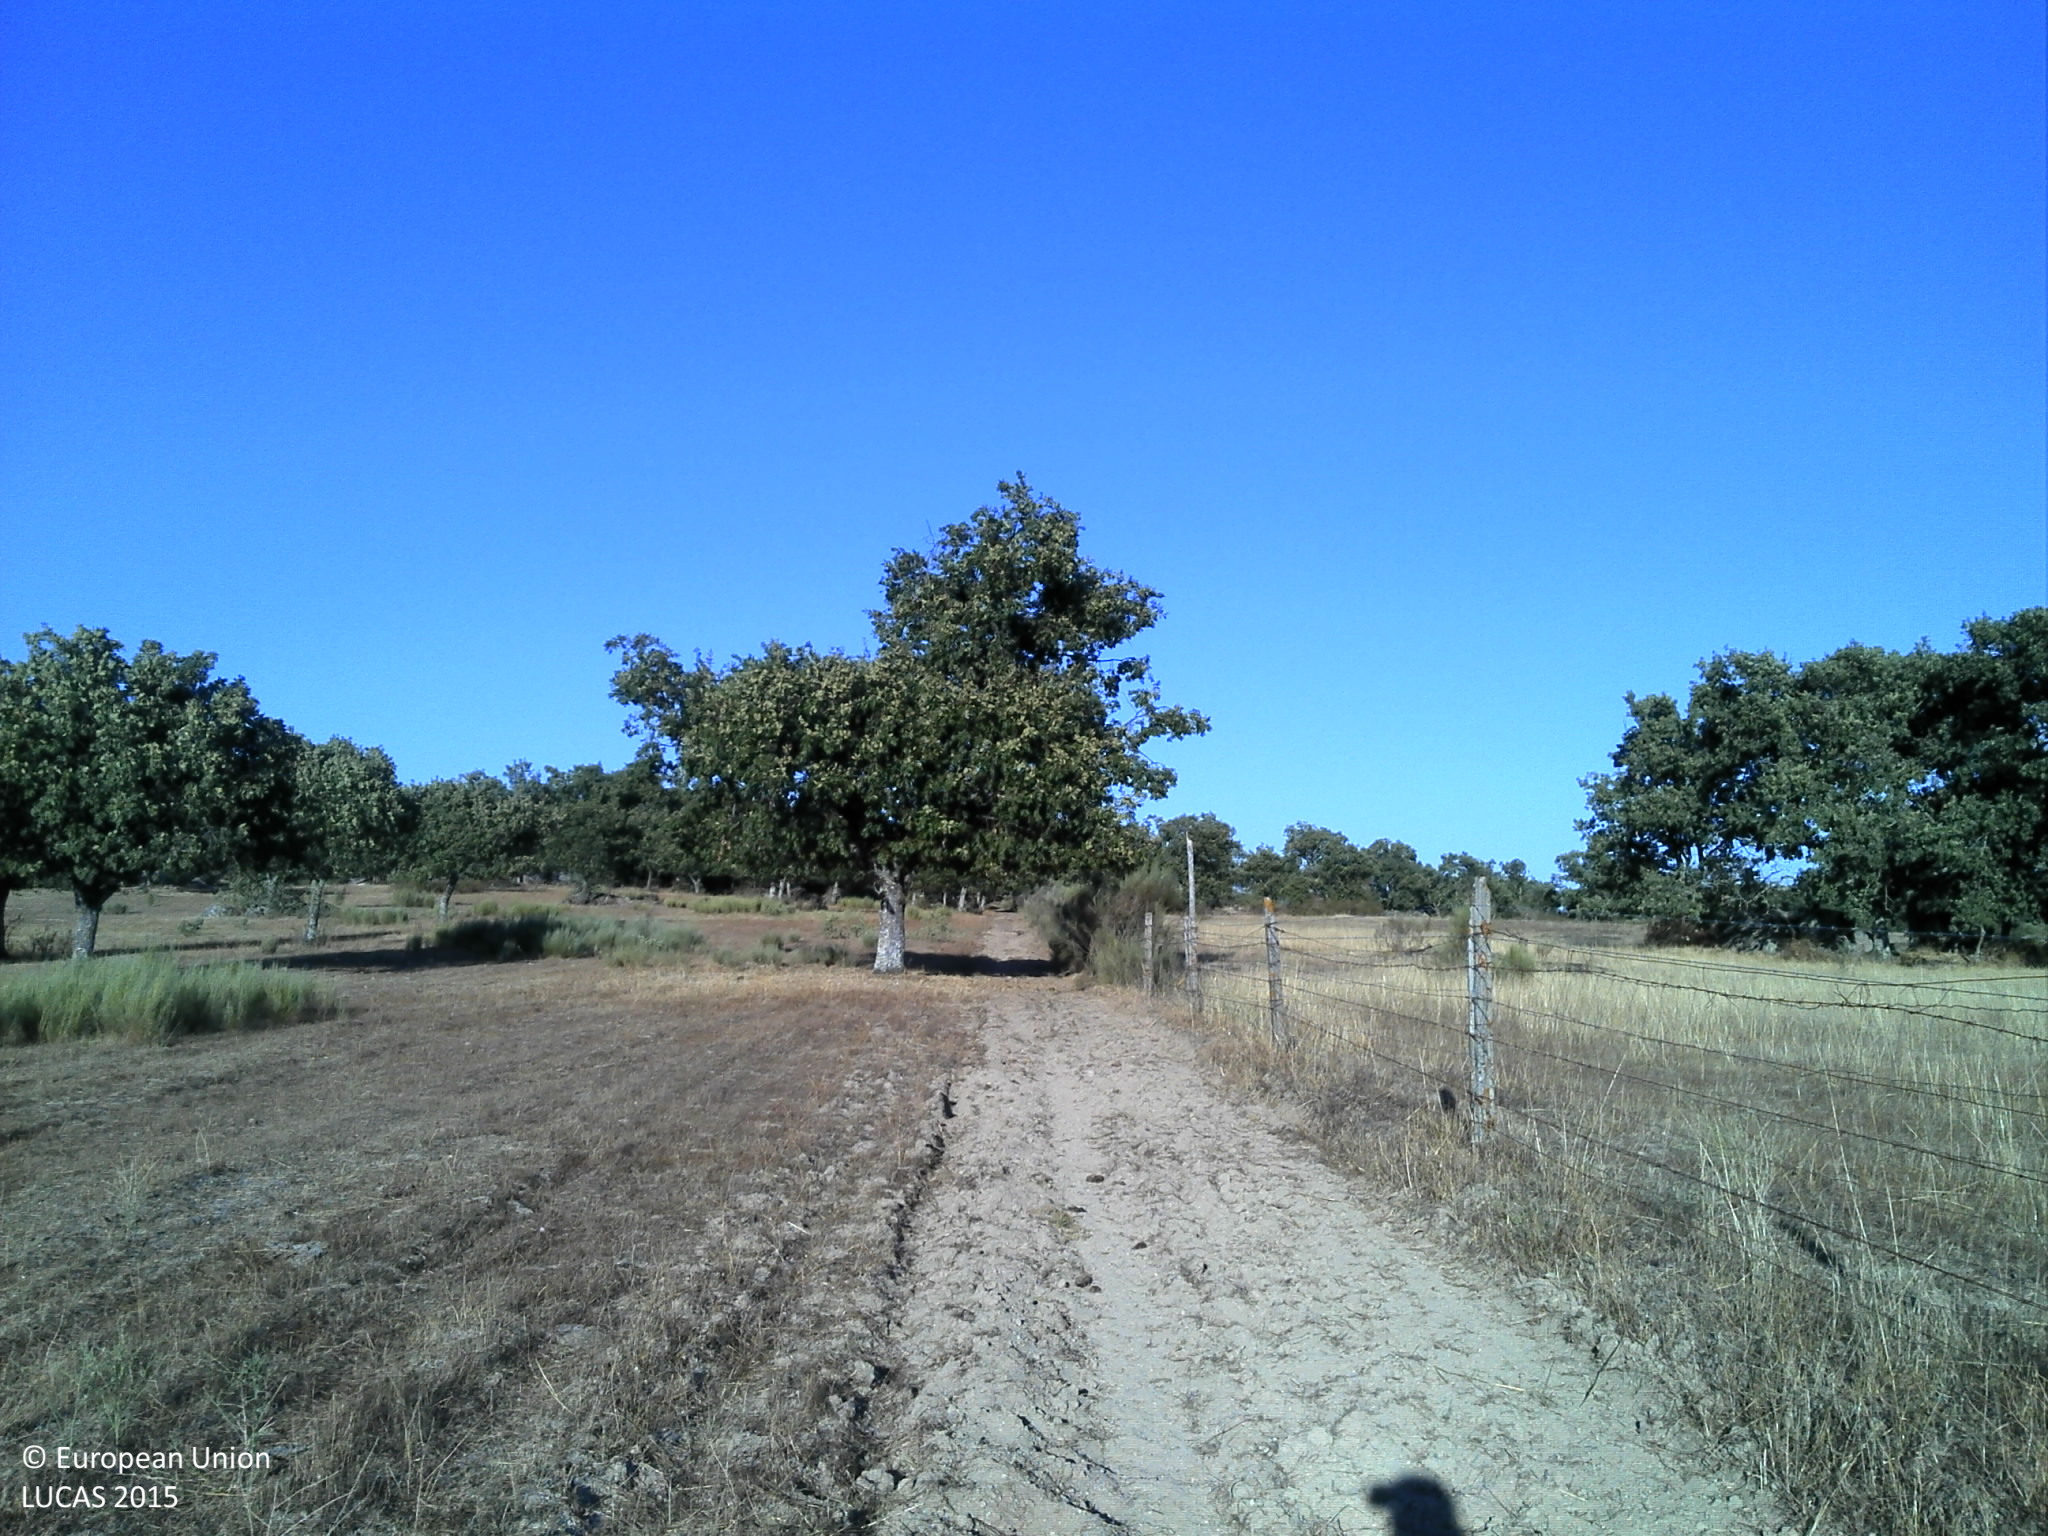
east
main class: Grassland
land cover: Grassland without tree/shrub cover
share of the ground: 25 - 50 %
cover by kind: unconsolidated bare surface 70 %, herbaceous plants 30 %
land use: Agriculture (excluding fallow land and kitchen gardens)
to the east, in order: Grassland without tree/shrub cover; Broadleaved woodland; Other bare soil; Broadleaved woodland; Other bare soil; Broadleaved woodland
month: August
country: PT
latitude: 39.4060
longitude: -7.5713
